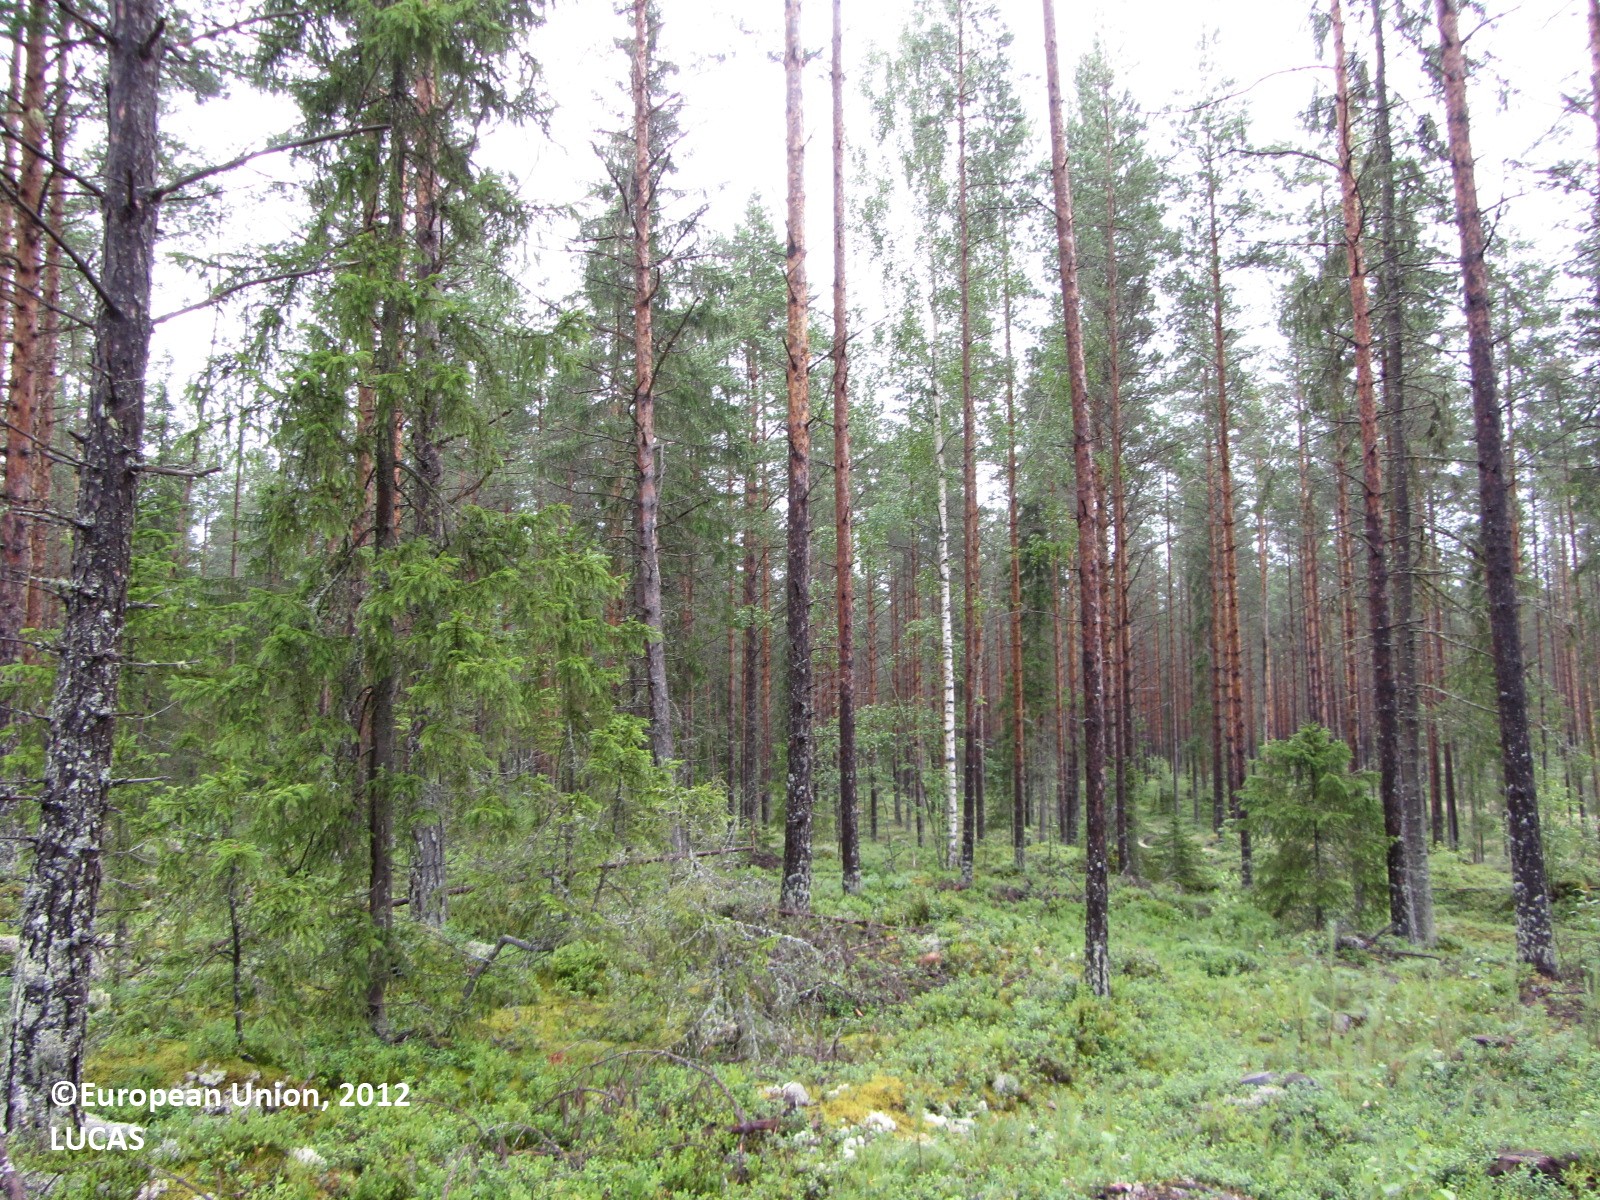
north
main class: Woodland
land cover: Pine dominated coniferous woodland
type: boreal forest
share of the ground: 50 - 75 %
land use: Forestry
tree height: > 5 m
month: July
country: FI
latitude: 63.9143
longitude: 24.8608
